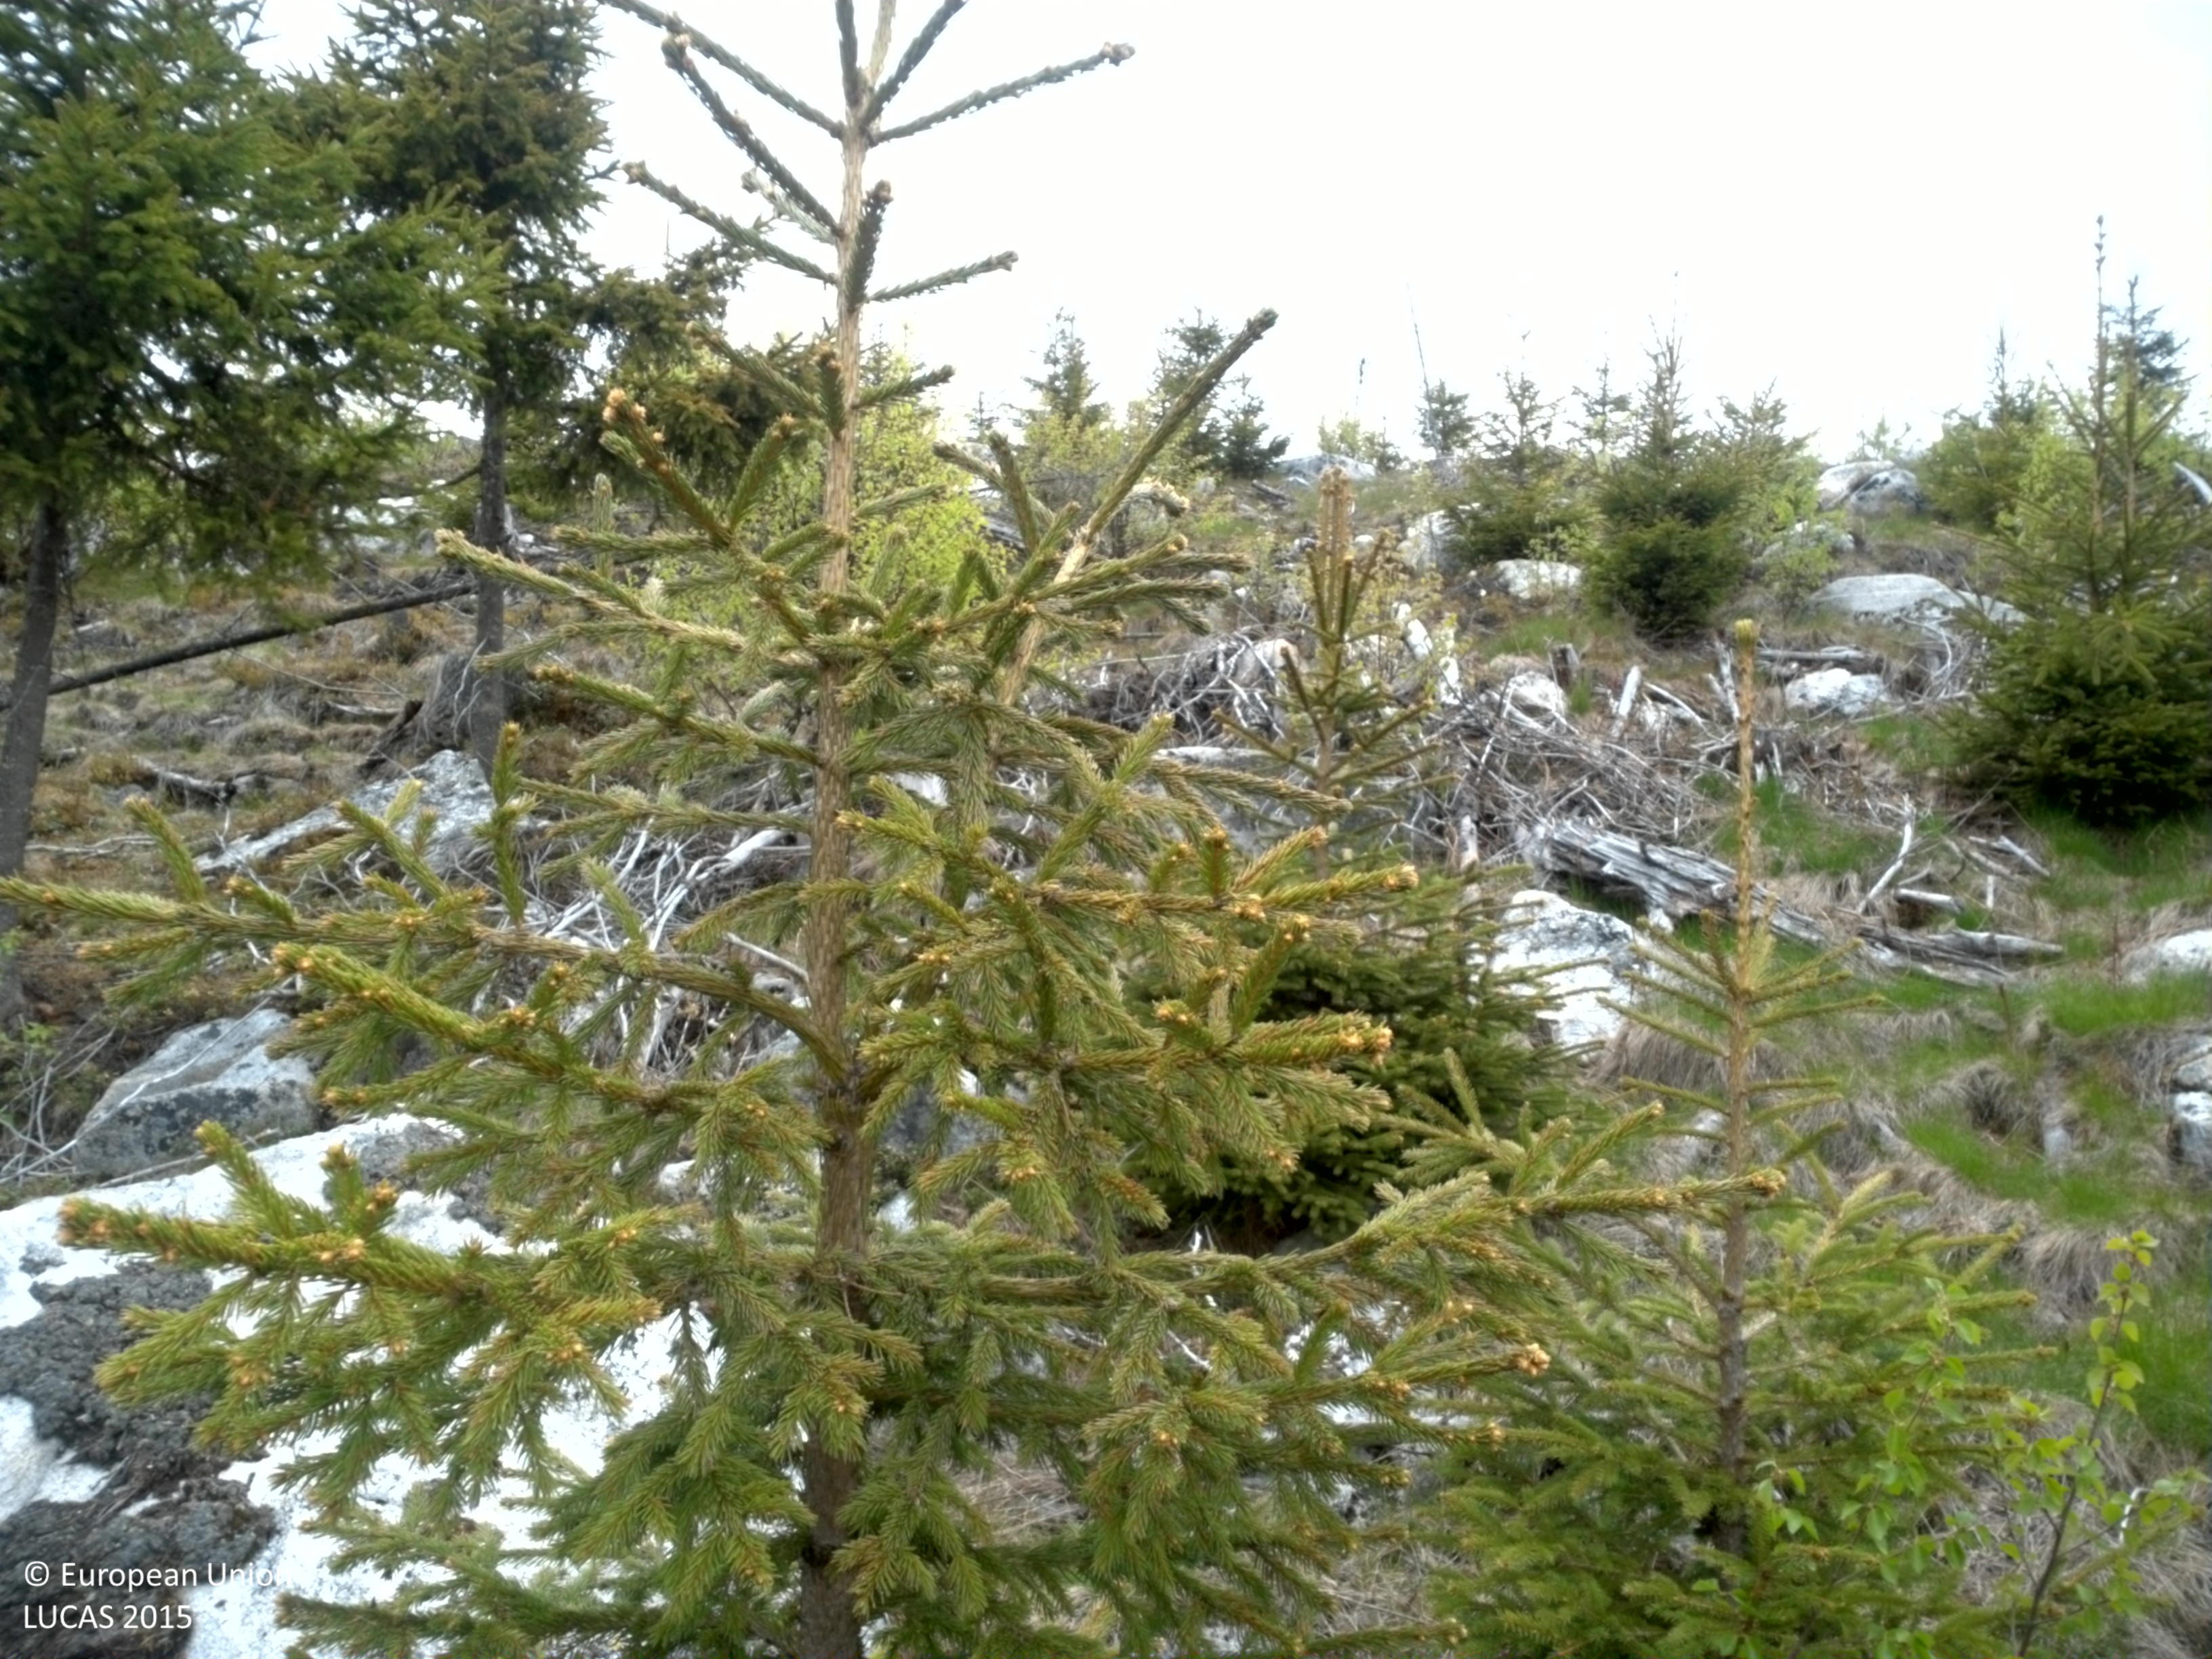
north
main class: Woodland
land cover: Spruce dominated coniferous woodland
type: boreal forest
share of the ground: 25 - 50 %
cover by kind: herbaceous plants 35 %, coniferous forest trees 30 %, unconsolidated bare surface 20 %, broadleaved forest trees 5 %, shrubs 5 %, lichens and mosses 5 %
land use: Forestry
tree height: < 5 m
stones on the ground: 25 - 50 %
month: June
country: SE
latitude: 64.3146
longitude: 17.4334
